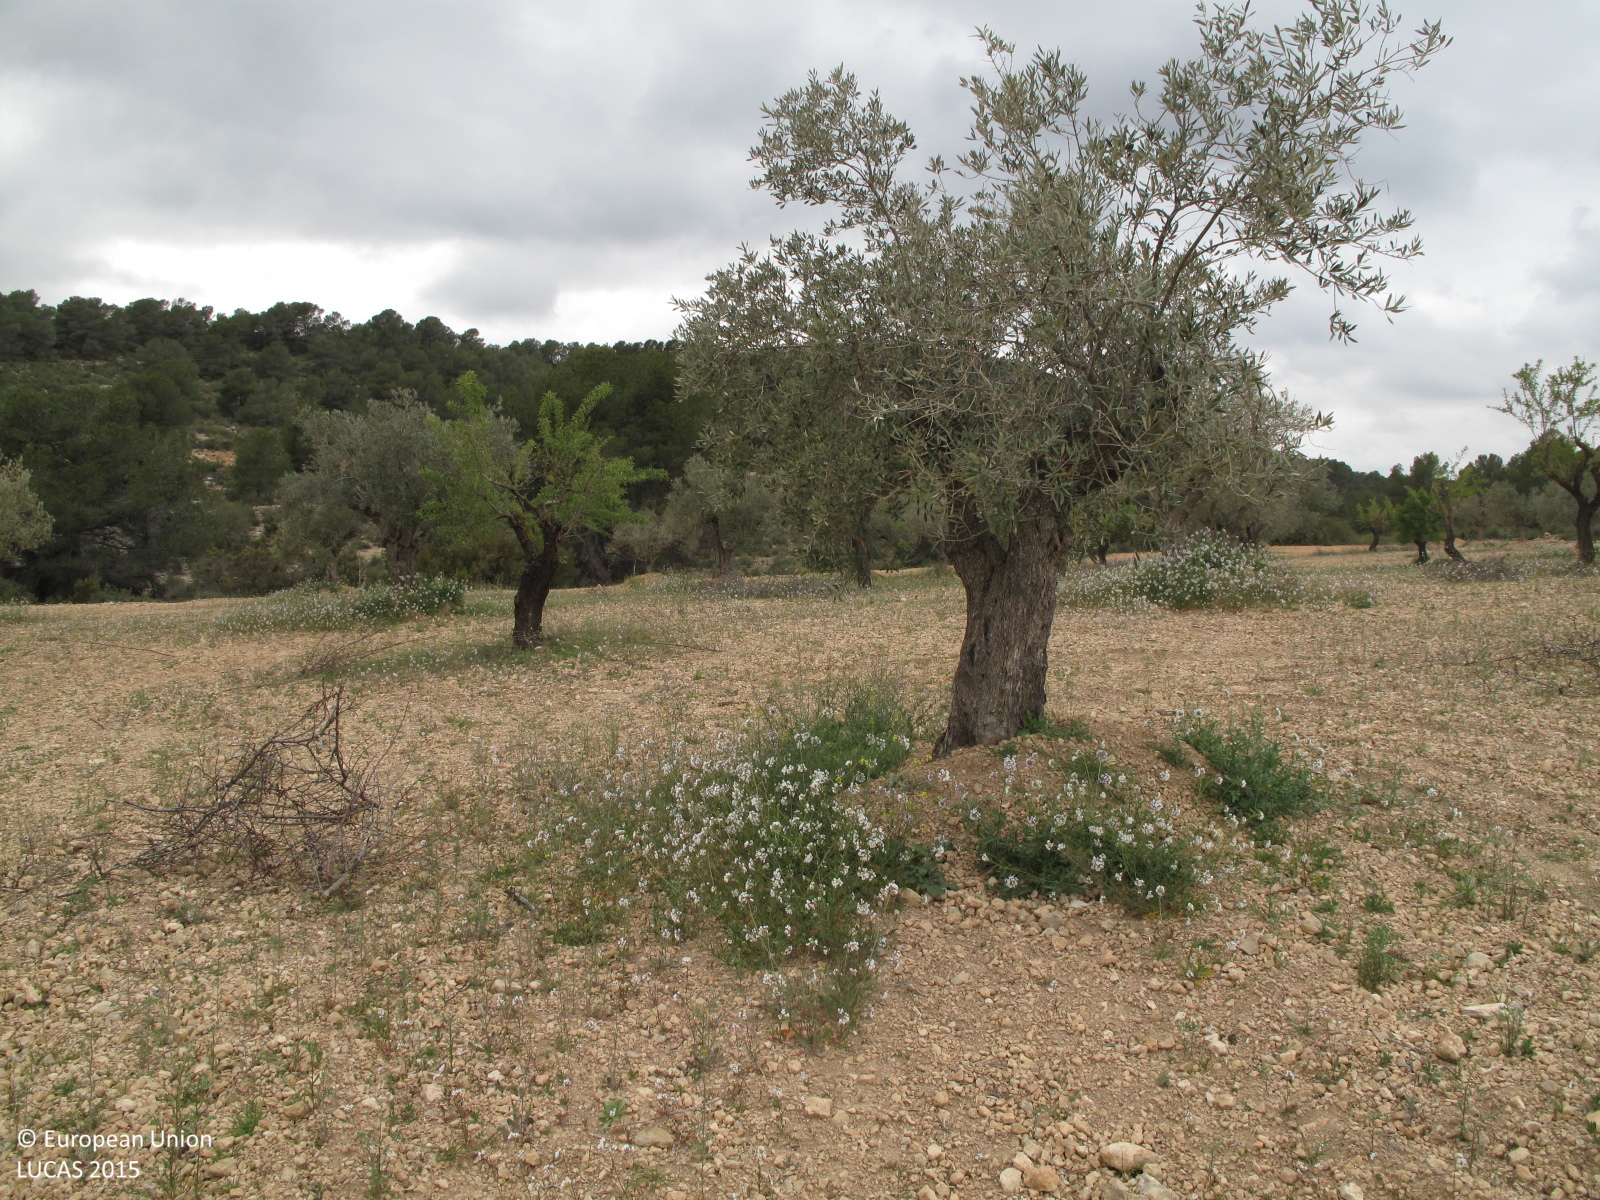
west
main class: Cropland
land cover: Olive groves
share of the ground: 25 - 50 %
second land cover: Nuts trees
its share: 25 - 50 %
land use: Agriculture (excluding fallow land and kitchen gardens)
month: April
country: ES
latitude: 38.7724
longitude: -0.9844
